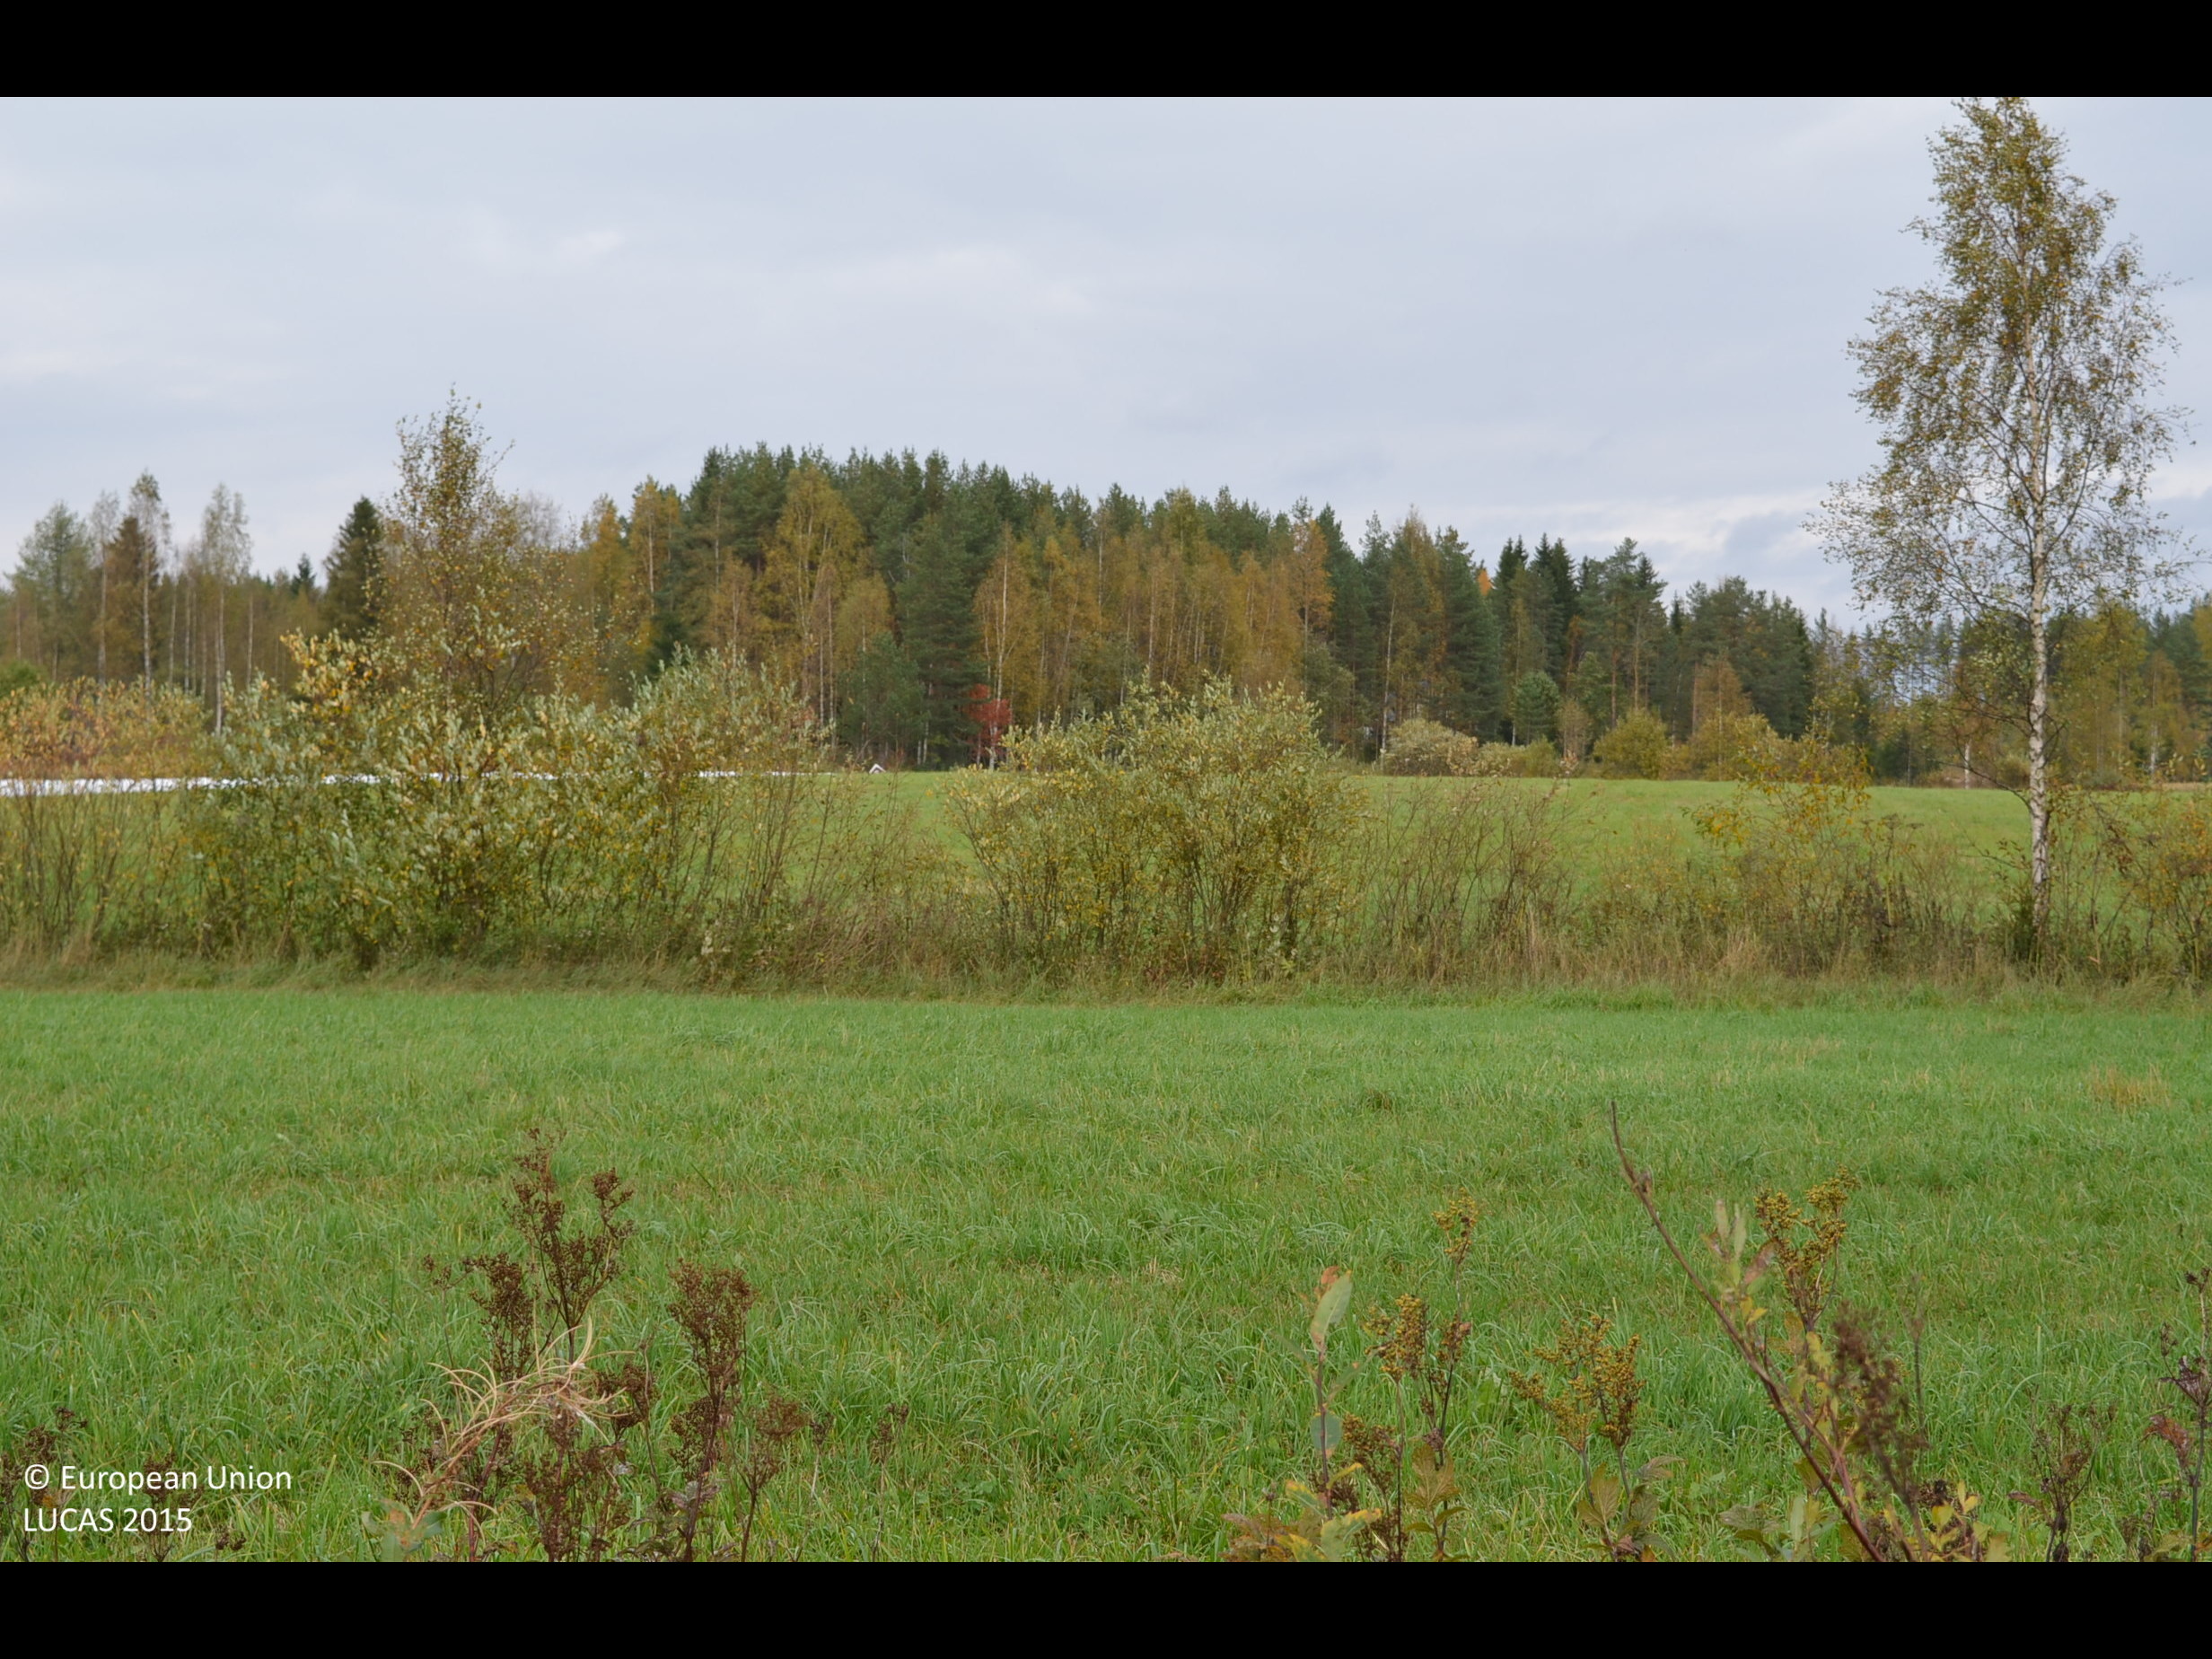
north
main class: Cropland
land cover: Temporary grasslands
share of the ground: > 75 %
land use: Agriculture (excluding fallow land and kitchen gardens)
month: September
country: FI
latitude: 62.4449
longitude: 23.6575
